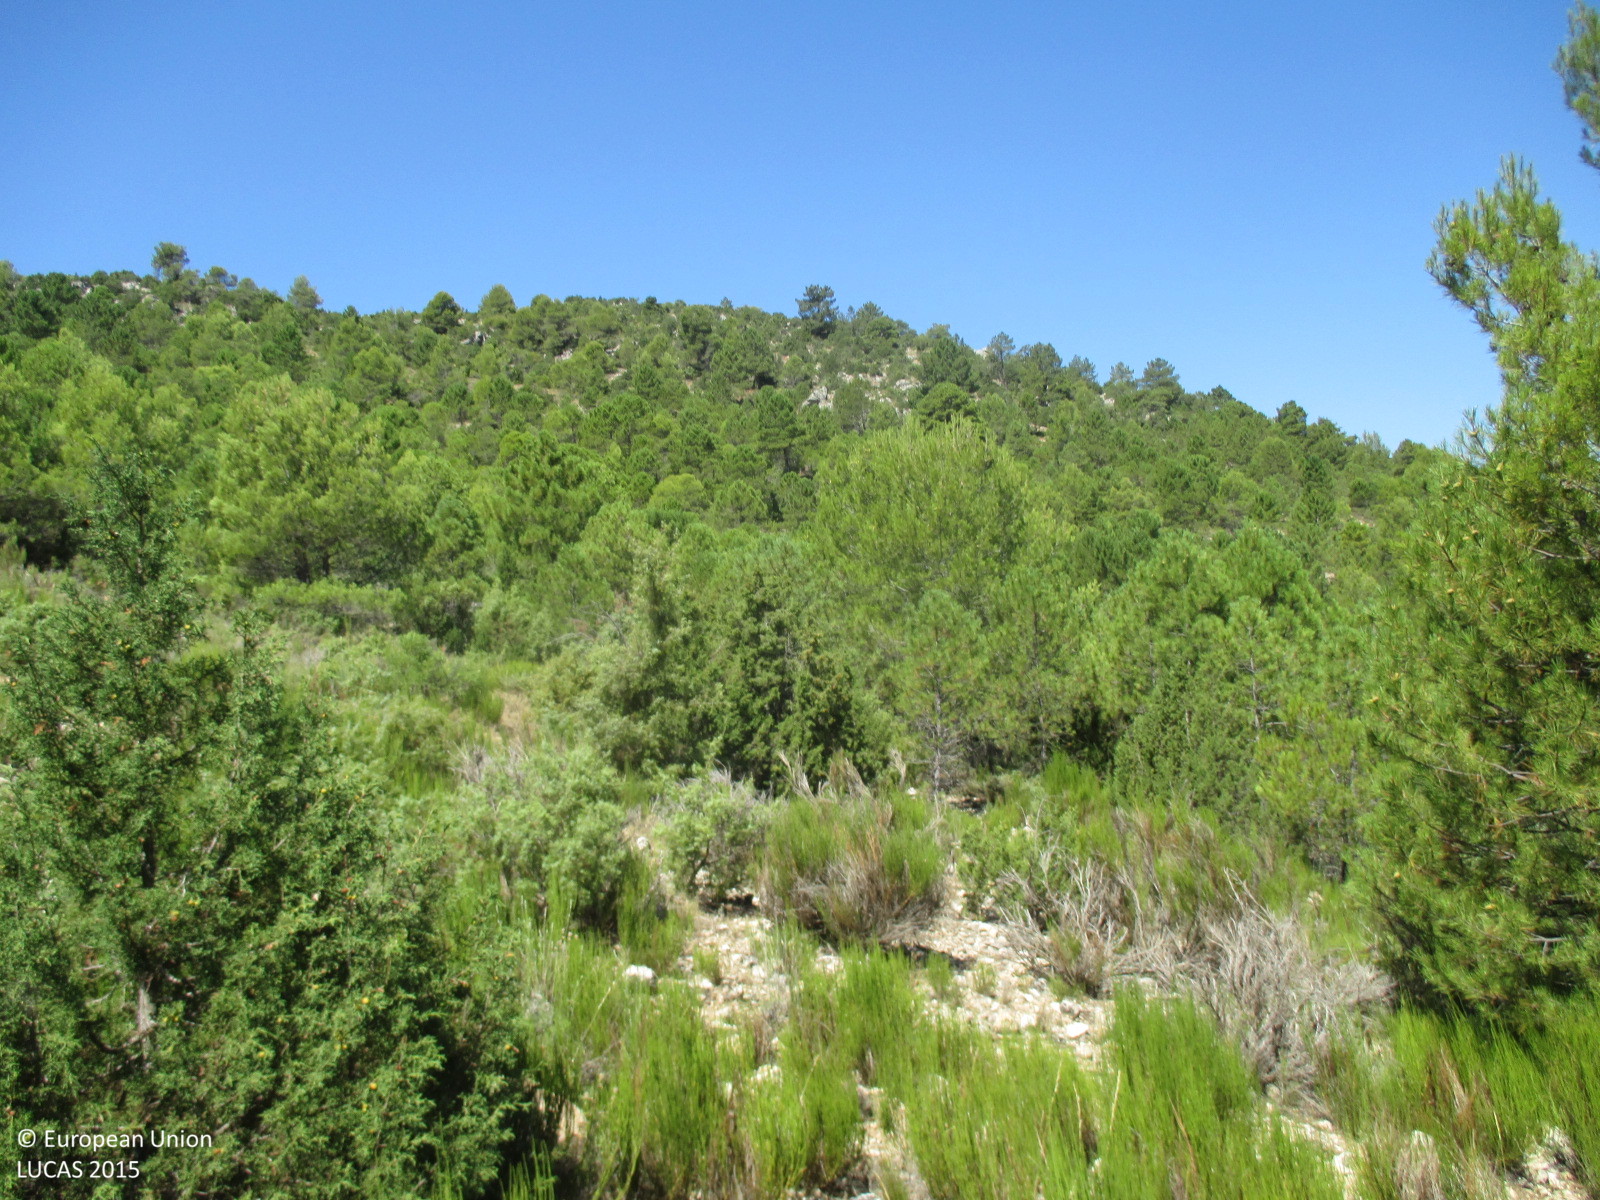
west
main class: Woodland
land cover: Pine dominated coniferous woodland
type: coniferous forest of the mediterranean region
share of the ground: 25 - 50 %
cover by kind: coniferous forest trees 40 %, shrubs 40 %, herbaceous plants 20 %
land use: Forestry
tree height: > 5 m
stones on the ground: < 10 %
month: July
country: ES
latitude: 38.2761
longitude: -2.3518
